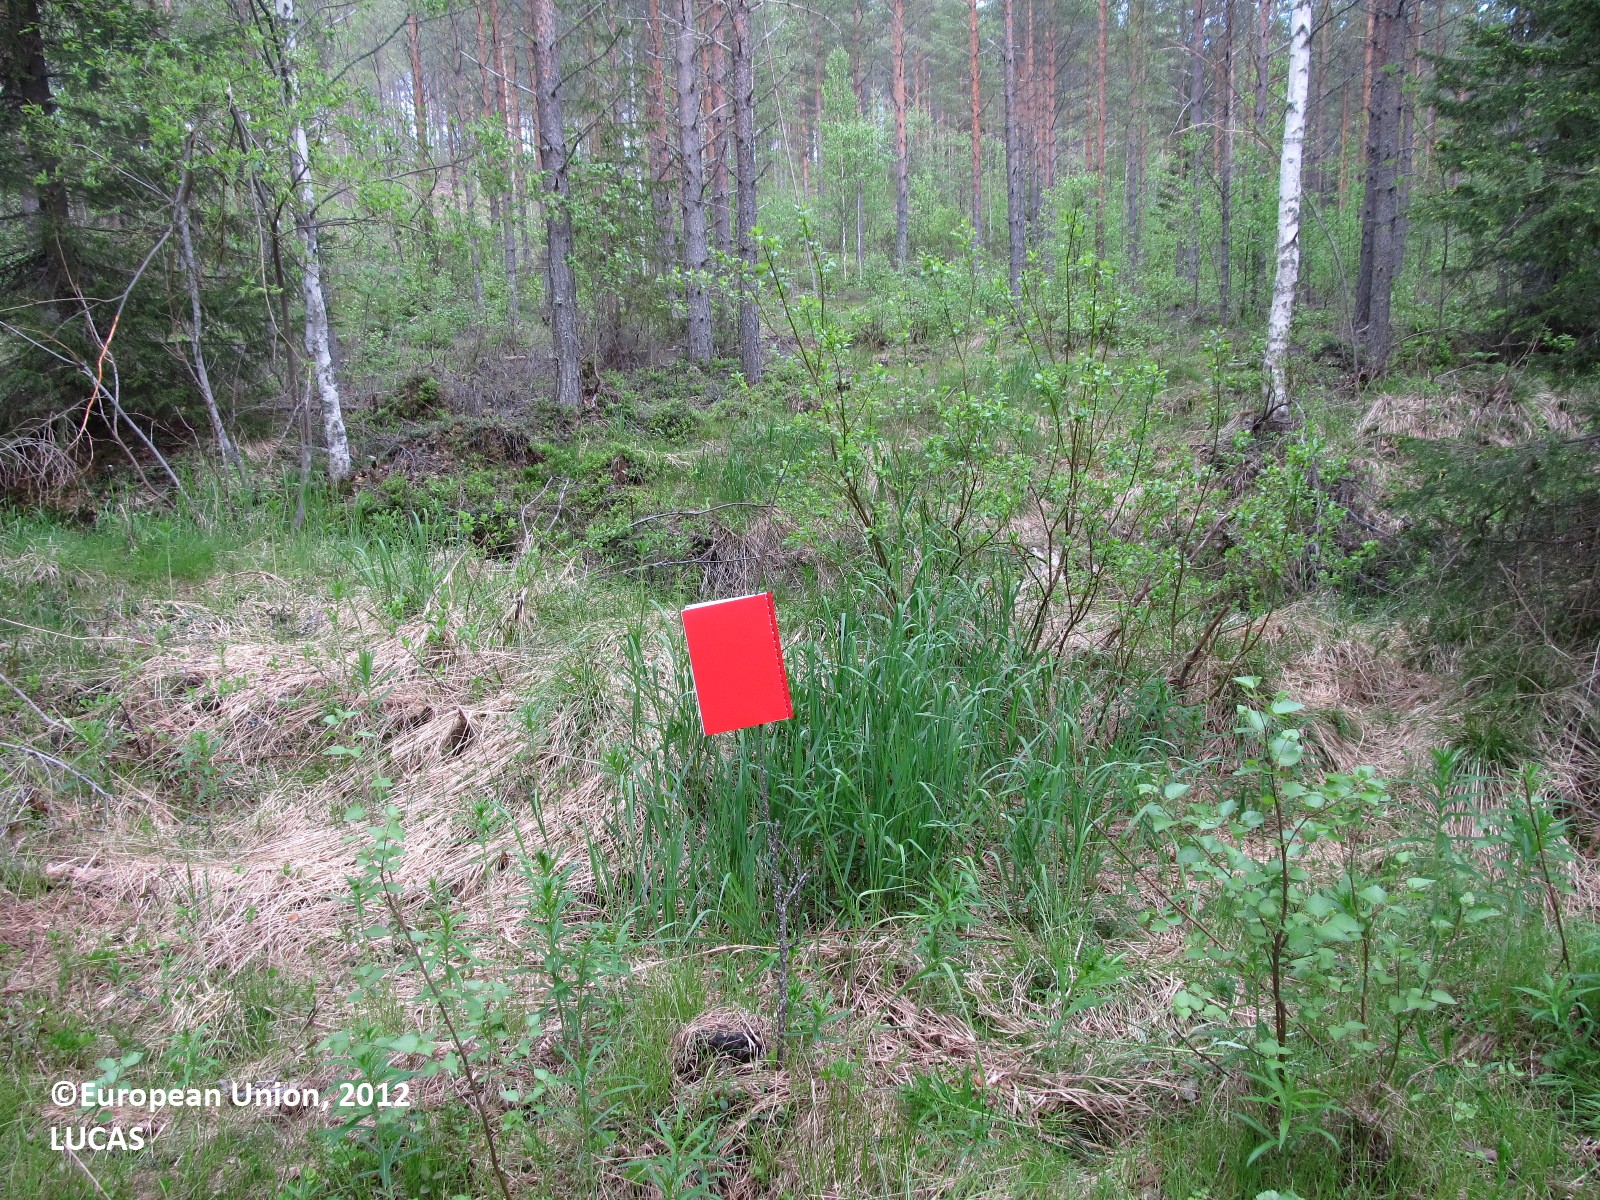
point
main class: Woodland
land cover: Pine dominated mixed woodland
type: boreal forest
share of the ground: 25 - 50 %
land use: Forestry
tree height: > 5 m
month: June
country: FI
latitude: 63.2274
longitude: 29.1814
